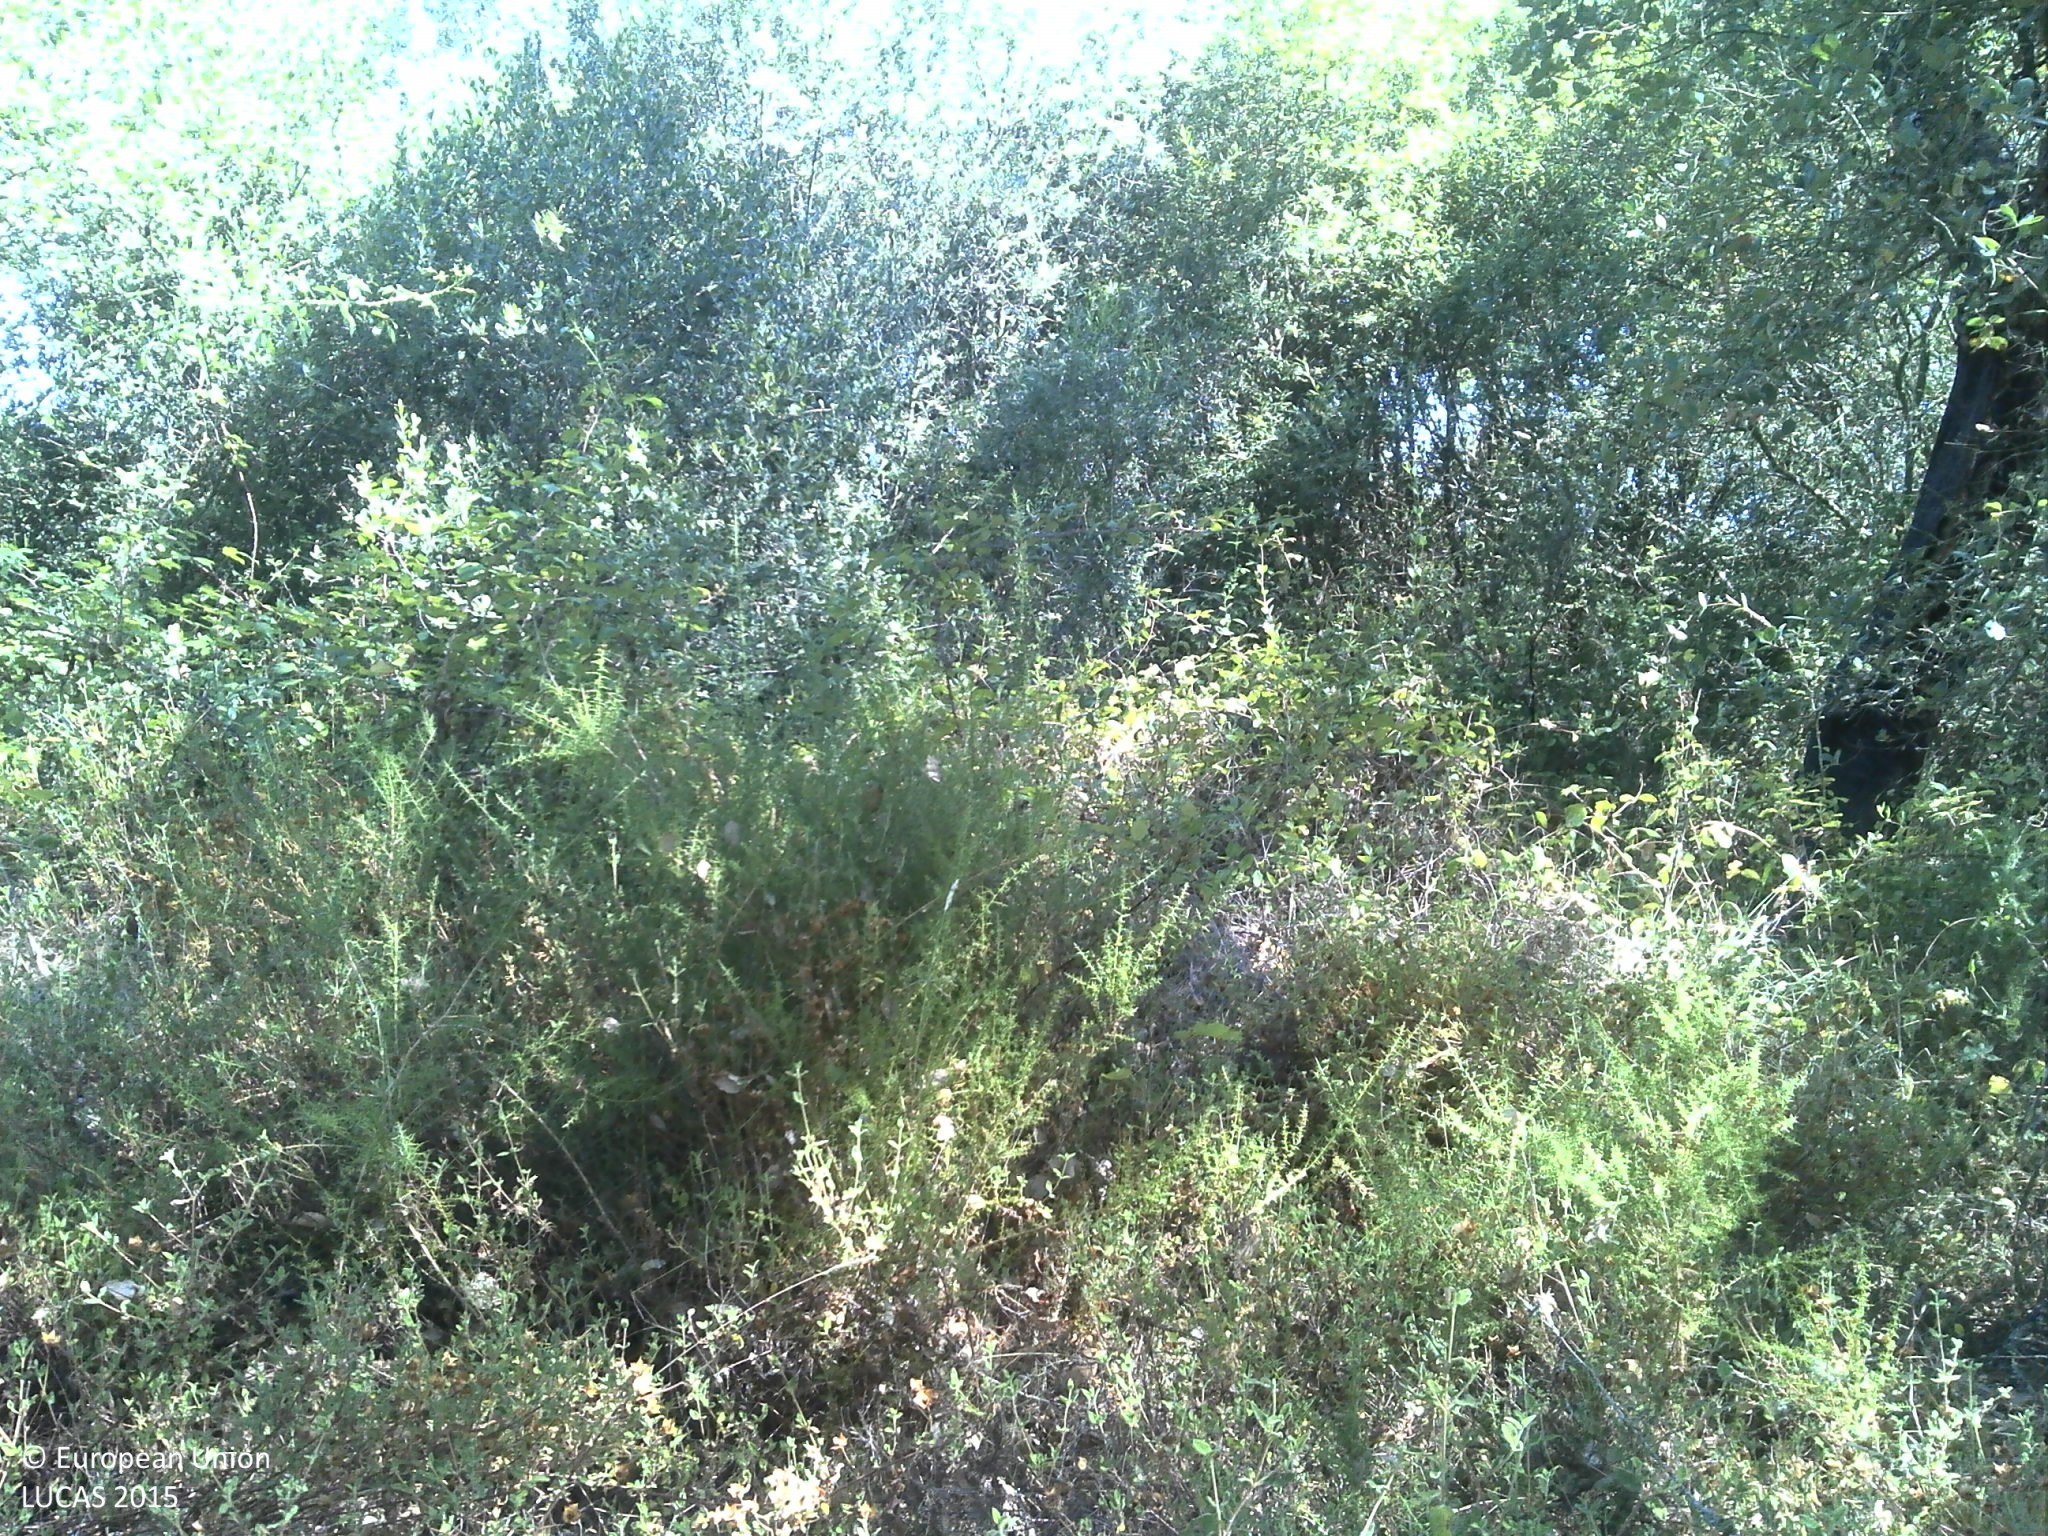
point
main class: Woodland
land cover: Broadleaved woodland
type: broadleaved evergreen forest
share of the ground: 50 - 75 %
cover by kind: broadleaved forest trees 70 %, unconsolidated bare surface 15 %, herbaceous plants 10 %, shrubs 5 %
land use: Forestry
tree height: > 5 m
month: July
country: PT
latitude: 39.2438
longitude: -8.2400
